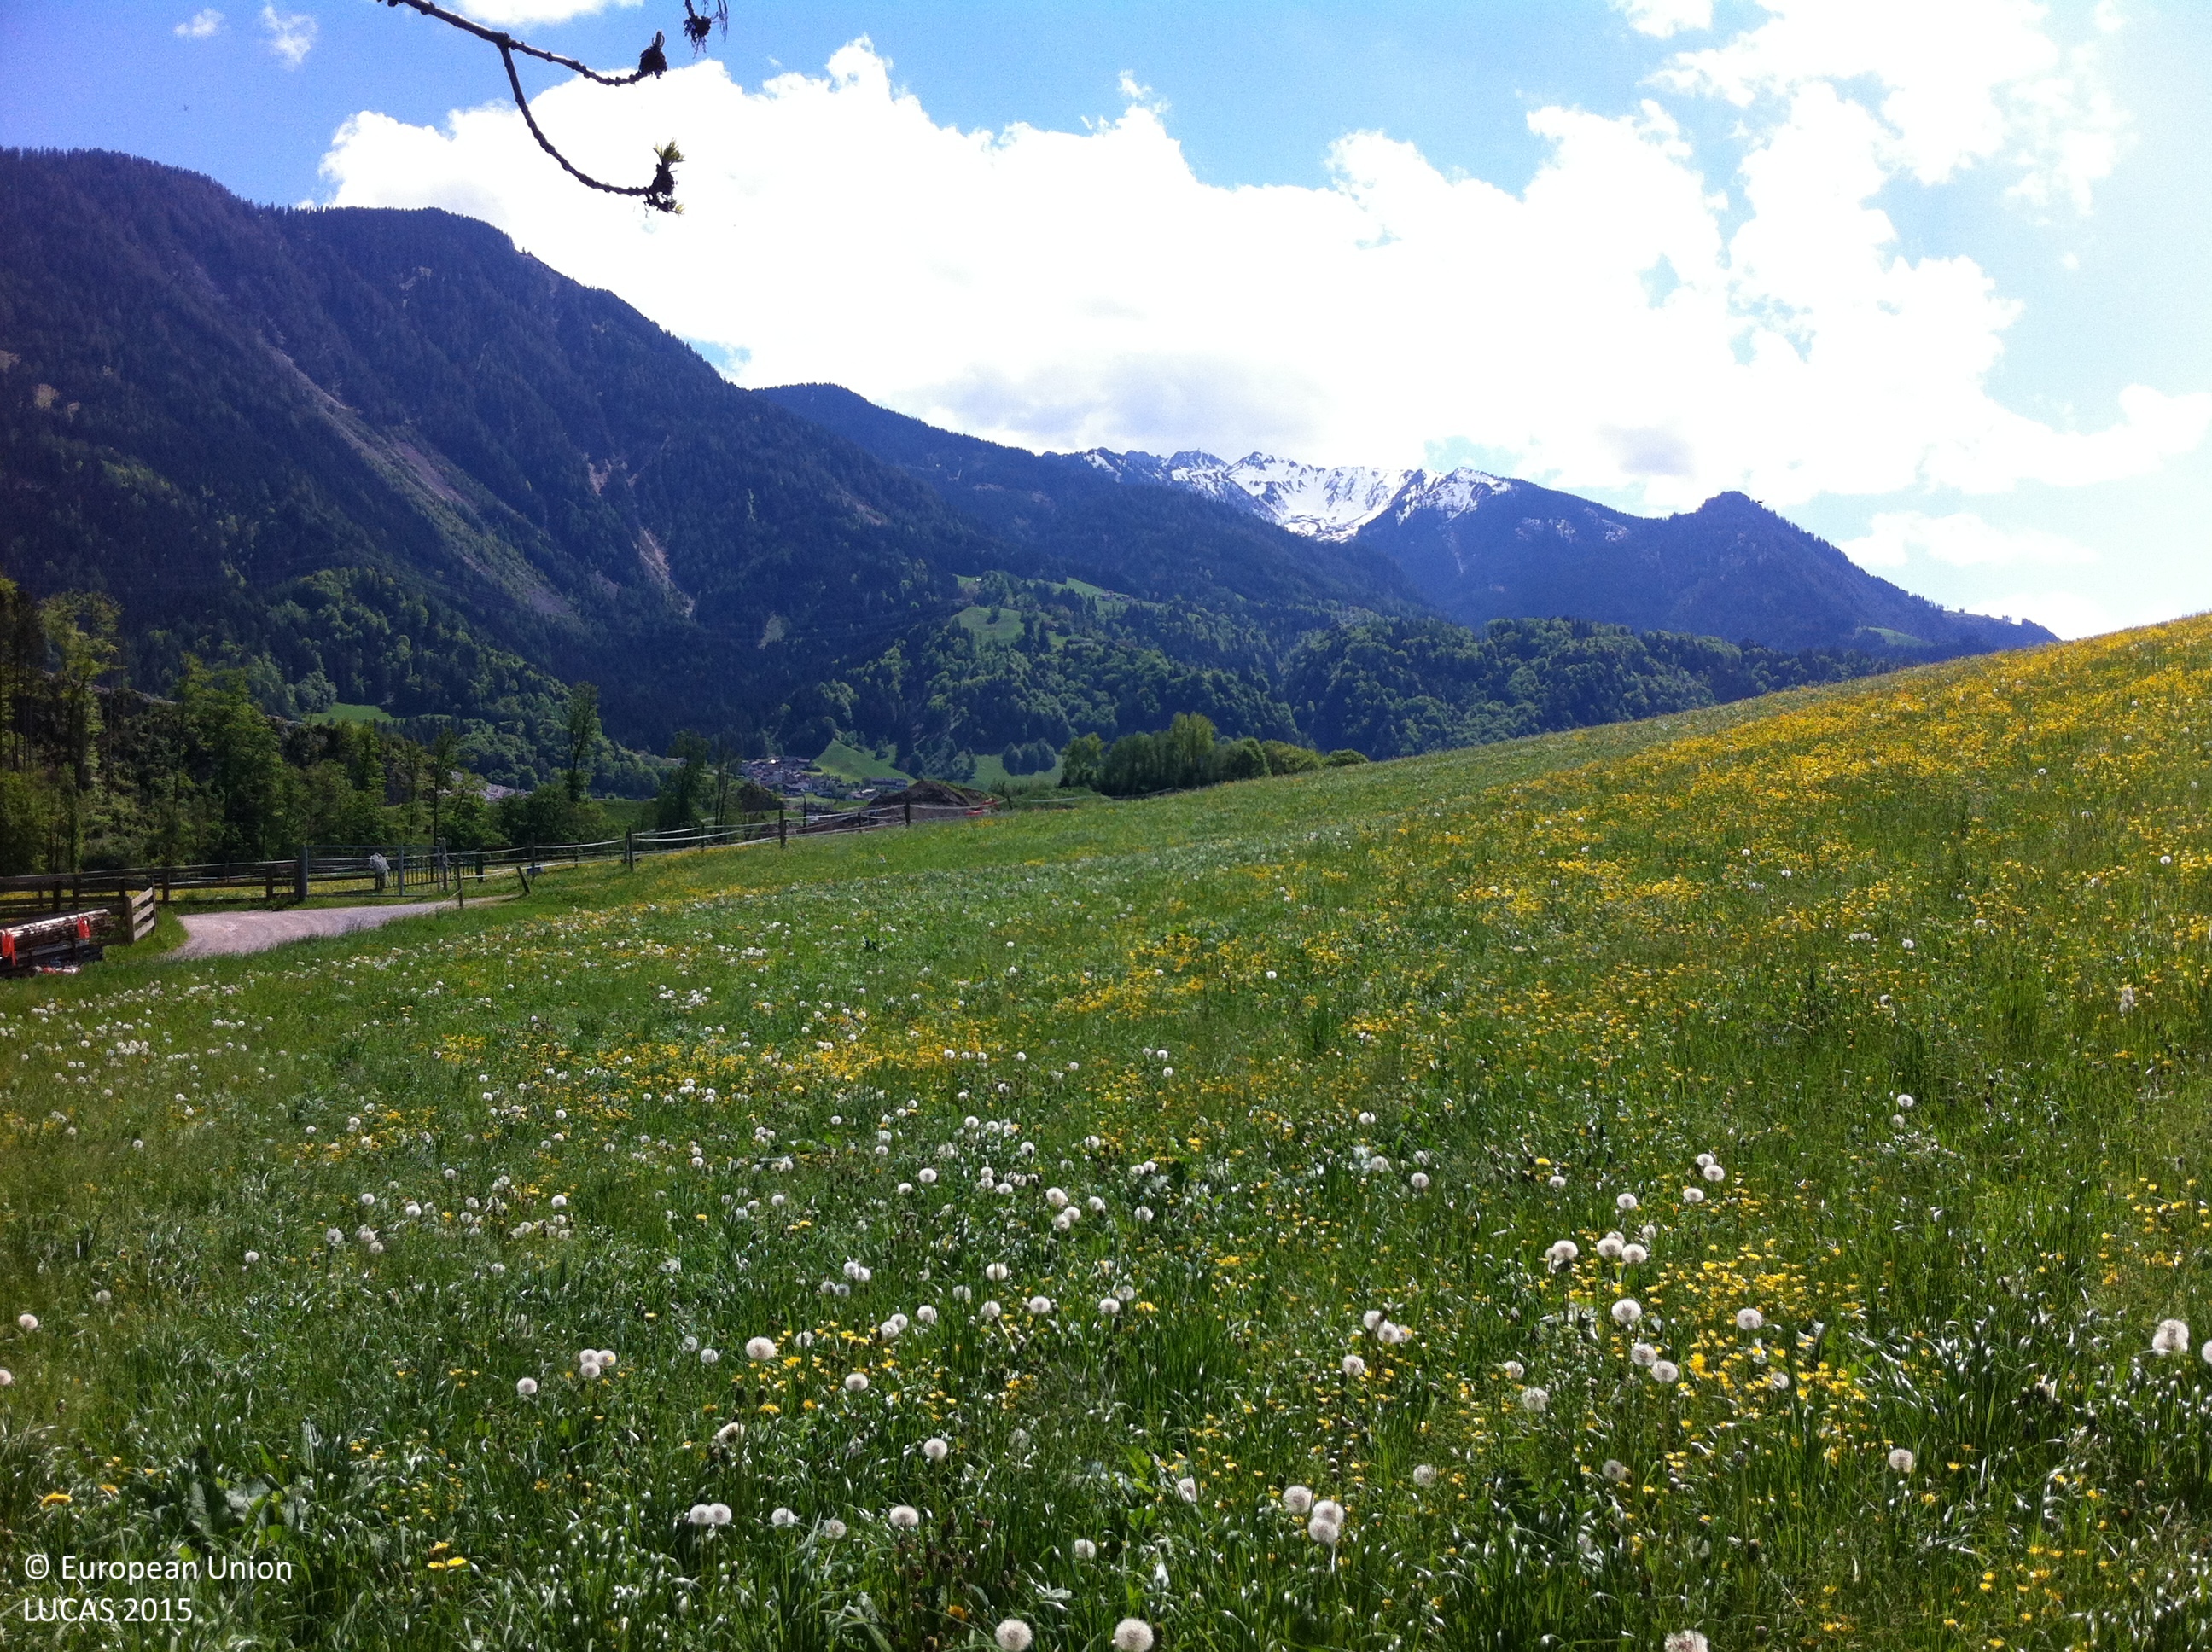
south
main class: Grassland
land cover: Grassland without tree/shrub cover
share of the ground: > 75 %
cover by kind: herbaceous plants 100 %
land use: Agriculture (excluding fallow land and kitchen gardens)
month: May
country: AT
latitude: 47.3989
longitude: 11.7873
